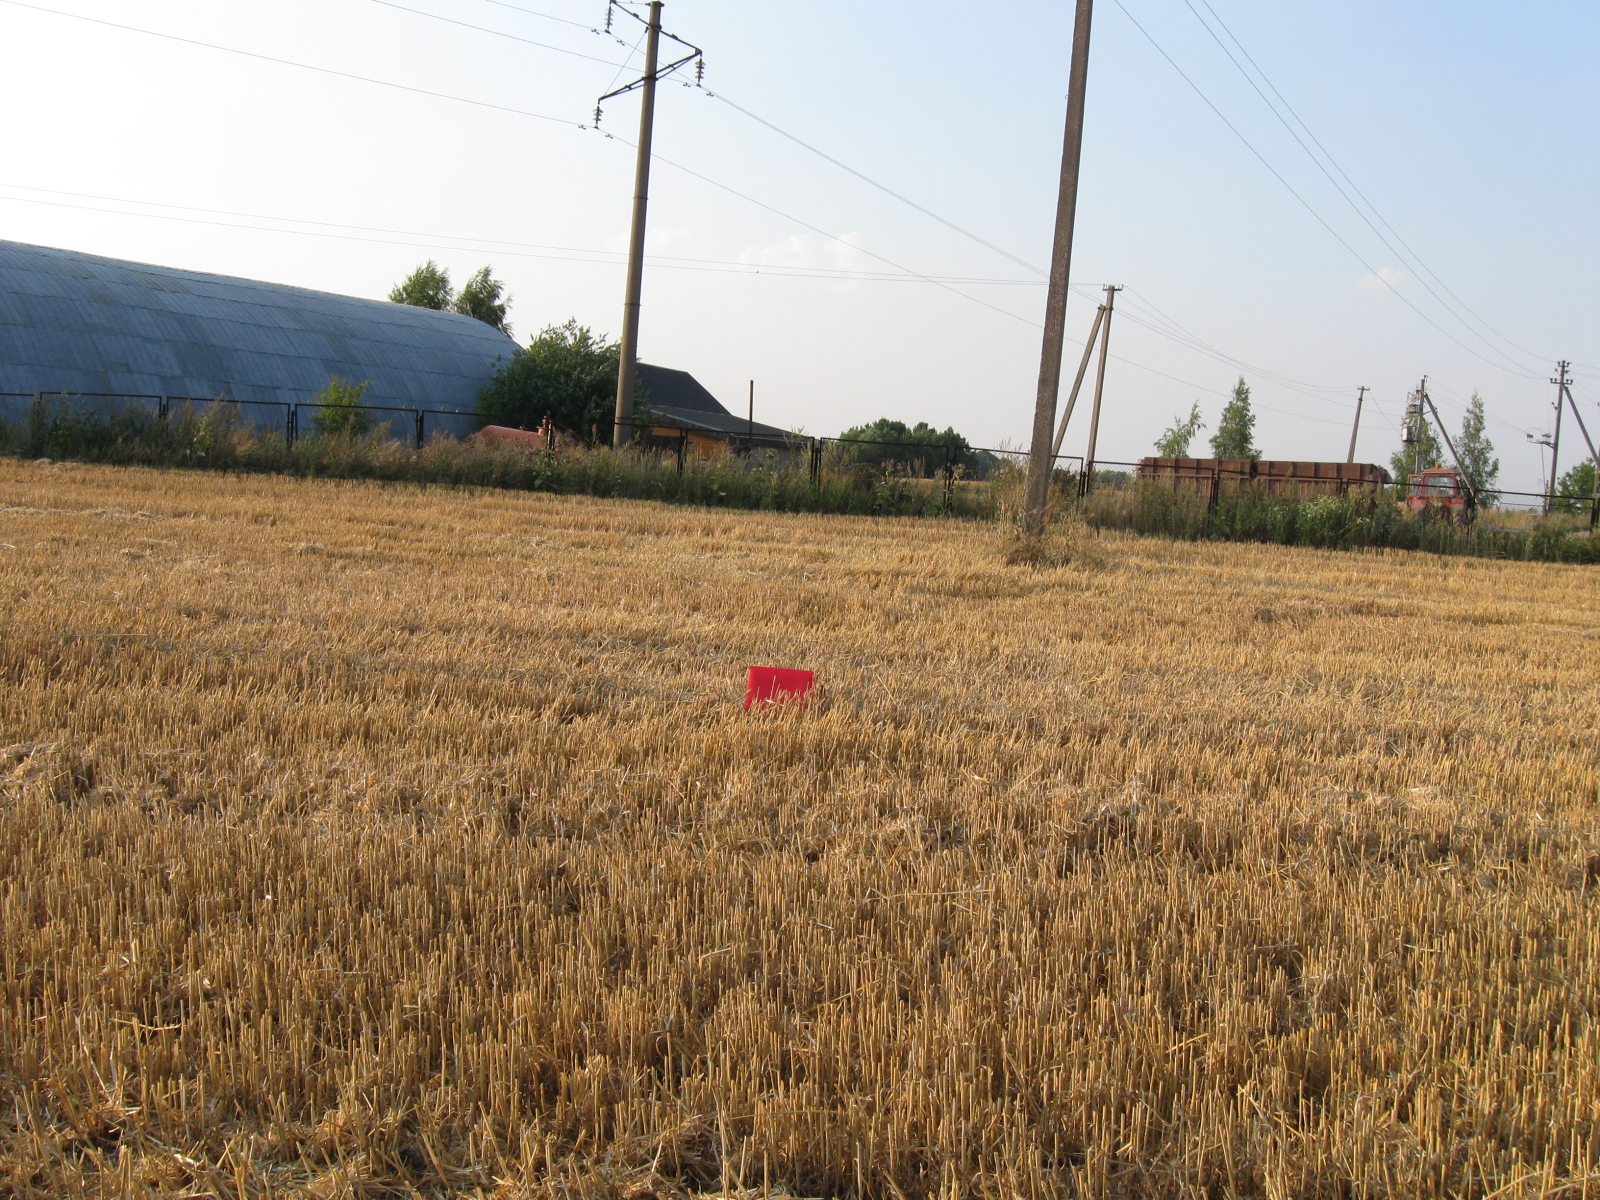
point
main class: Cropland
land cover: Common wheat
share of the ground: < 10 %
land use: Agriculture (excluding fallow land and kitchen gardens)
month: August
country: LT
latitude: 54.4727
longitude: 23.2711
